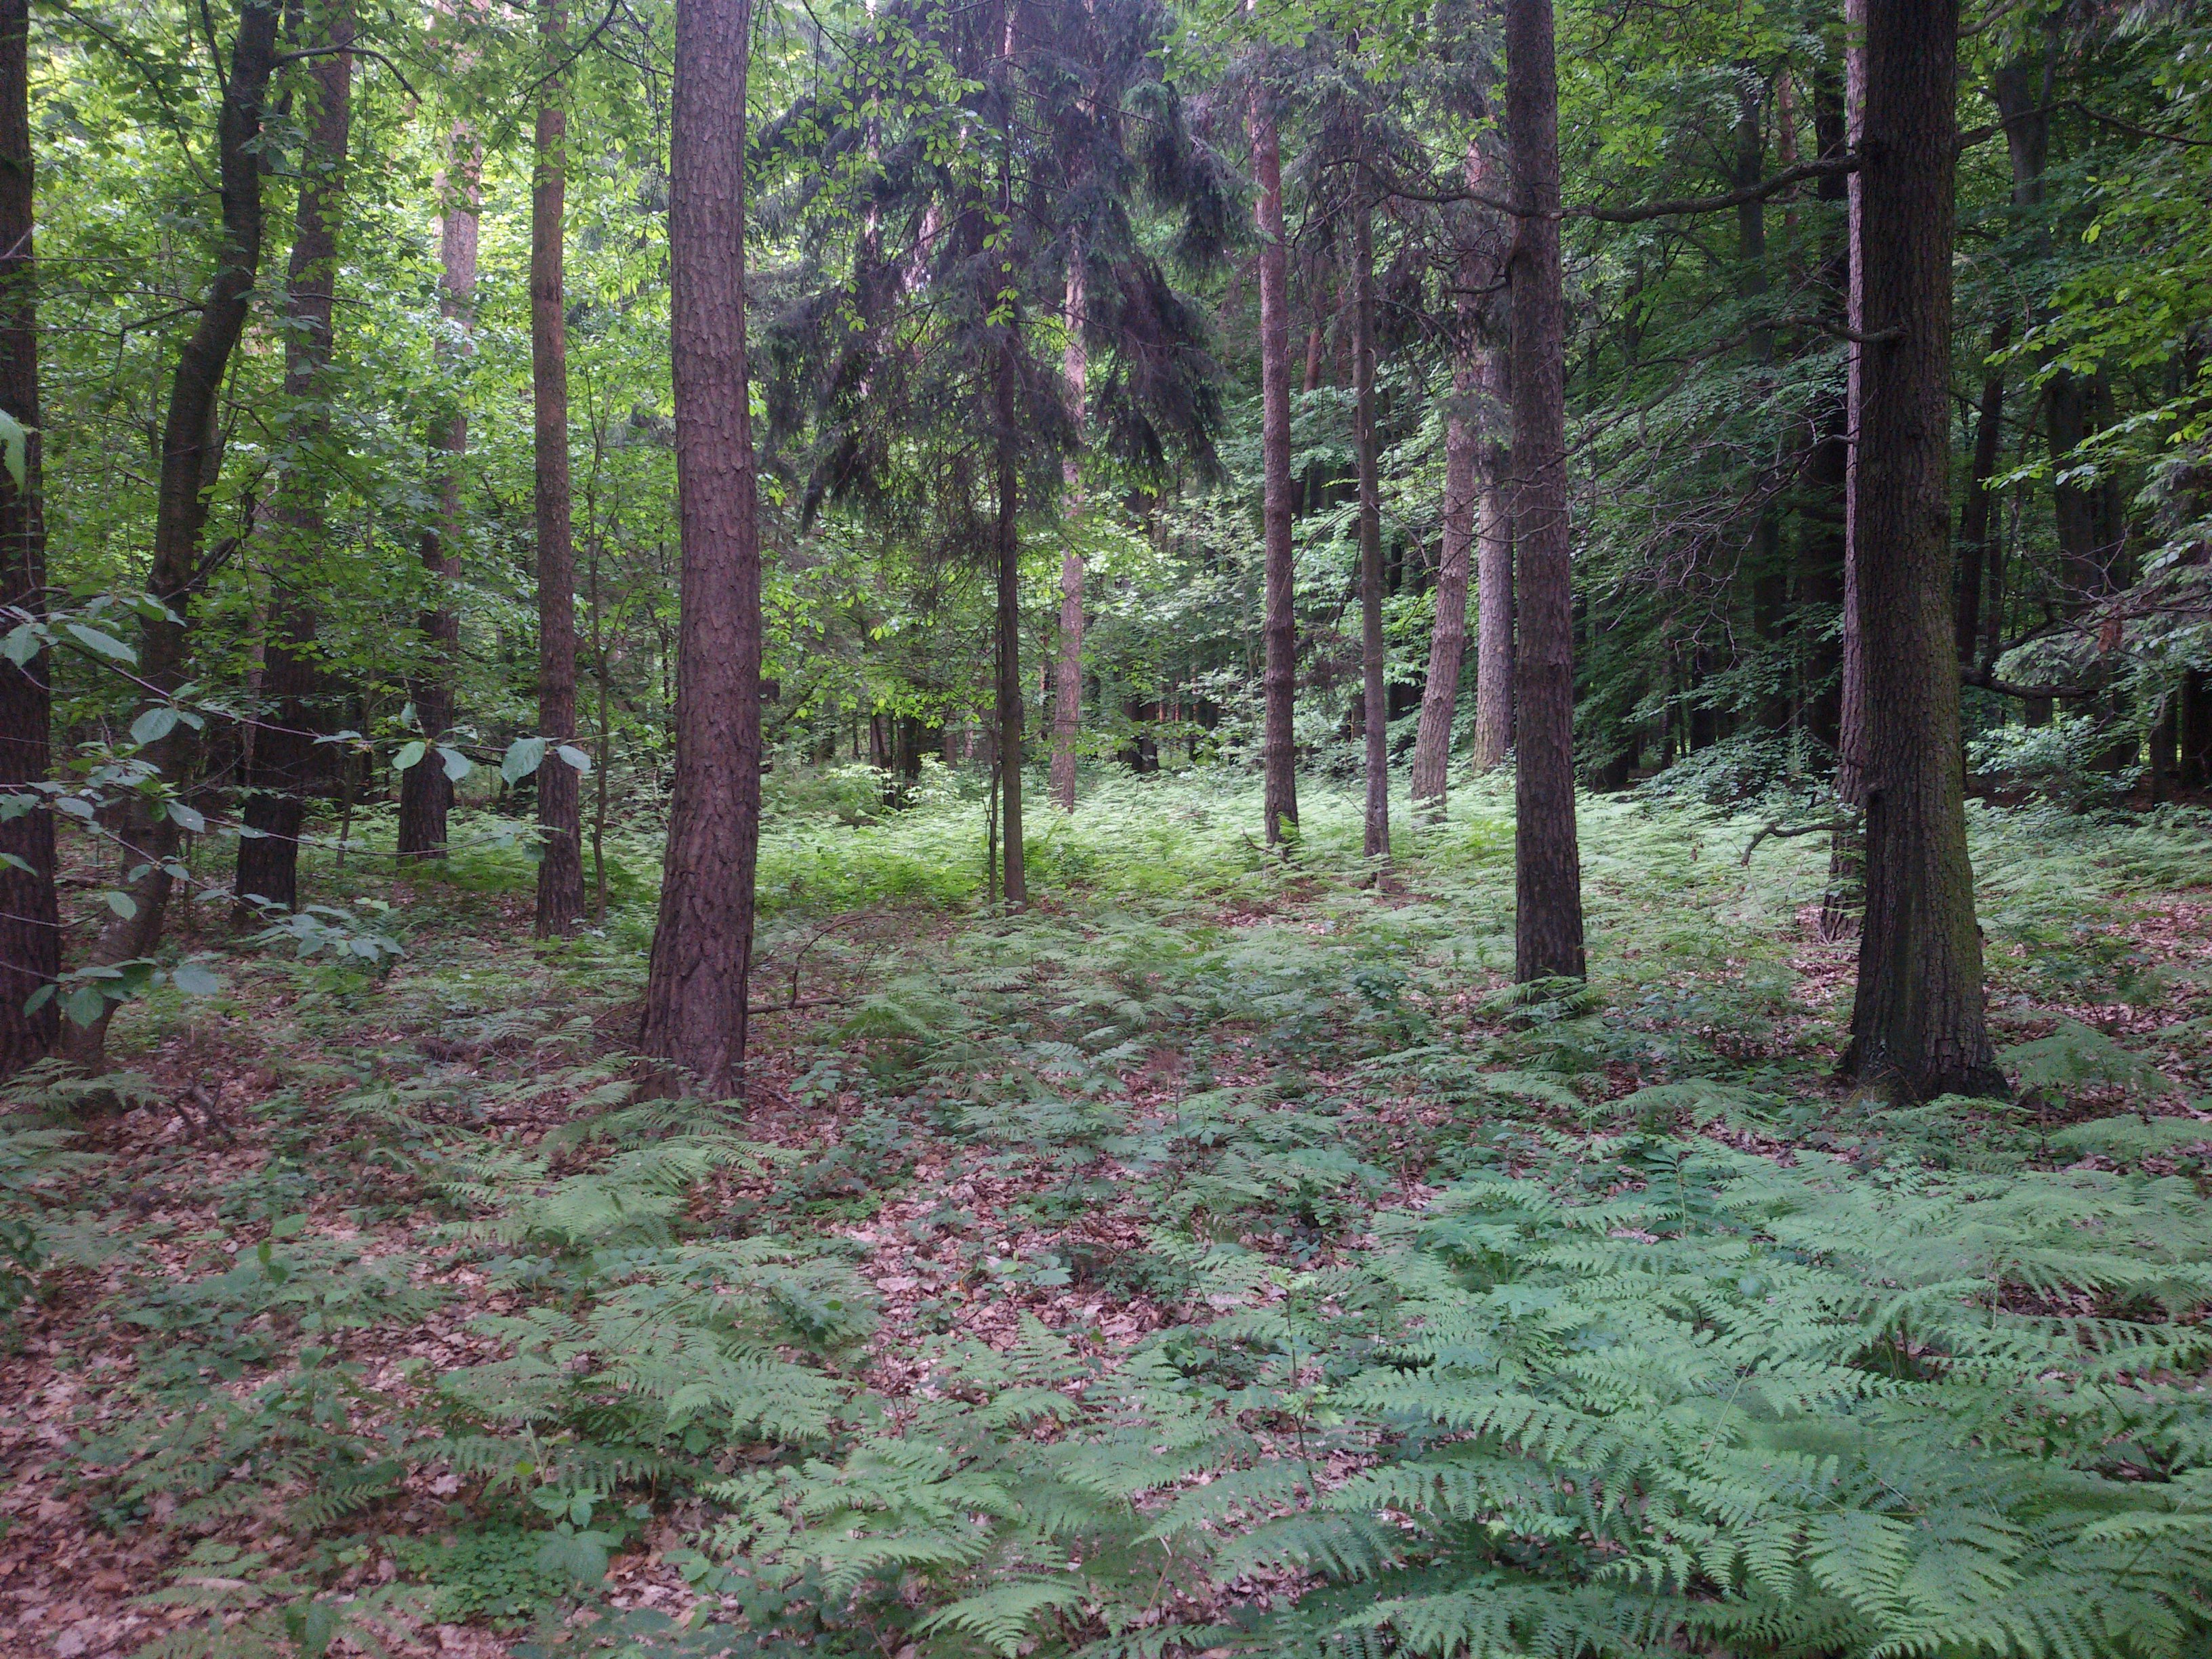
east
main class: Woodland
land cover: Pine dominated mixed woodland
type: hemiboreal forest and nemoral coniferous forest and mixed broadleaved-coniferous forest
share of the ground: > 75 %
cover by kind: coniferous forest trees 60 %, broadleaved forest trees 30 %, herbaceous plants 5 %, lichens and mosses 5 %
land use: Forestry
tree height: > 5 m
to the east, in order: Pine dominated mixed woodland
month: May
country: PL
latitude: 50.5705
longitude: 17.1978
